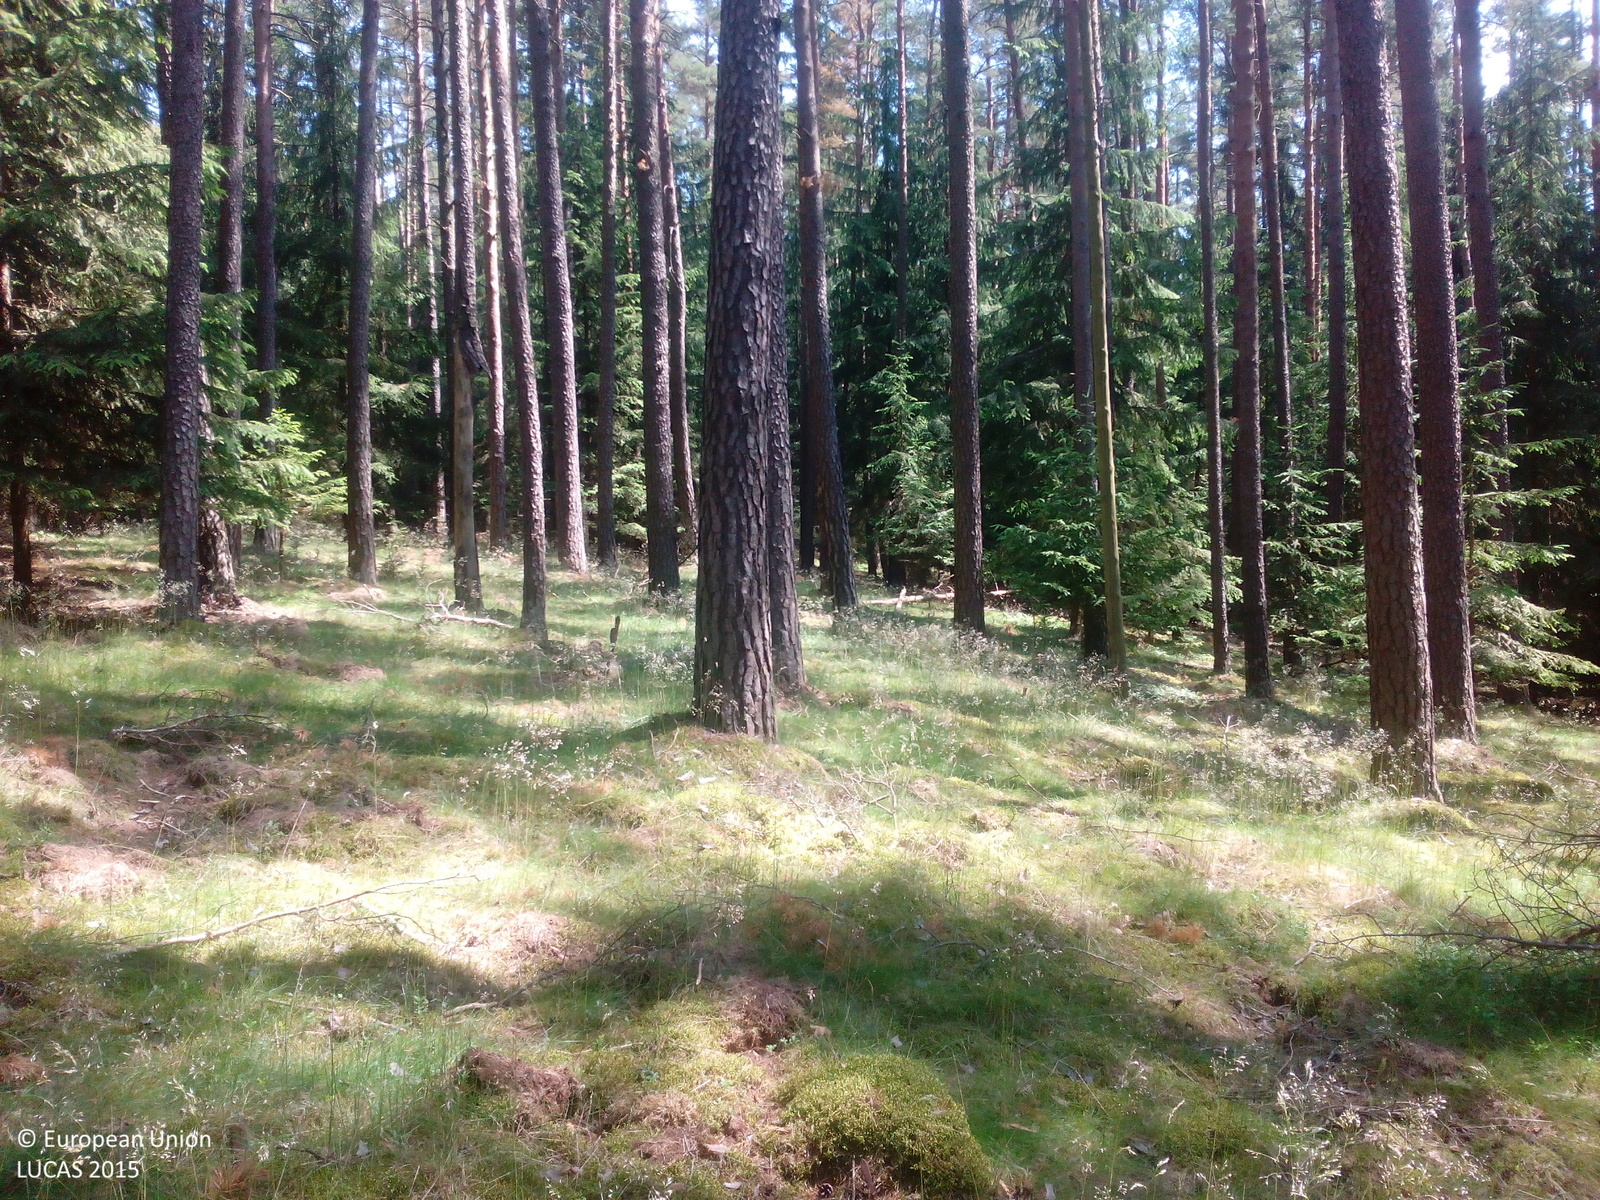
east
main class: Woodland
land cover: Pine dominated coniferous woodland
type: hemiboreal forest and nemoral coniferous forest and mixed broadleaved-coniferous forest
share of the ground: 25 - 50 %
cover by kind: coniferous forest trees 45 %, herbaceous plants 25 %, lichens and mosses 25 %, unconsolidated bare surface 5 %
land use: Forestry
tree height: > 5 m
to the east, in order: Pine dominated coniferous woodland; Other coniferous woodland; Tracks; Pine dominated coniferous woodland; Spruce dominated coniferous woodland
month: June
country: DE
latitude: 50.0943
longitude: 12.0265
